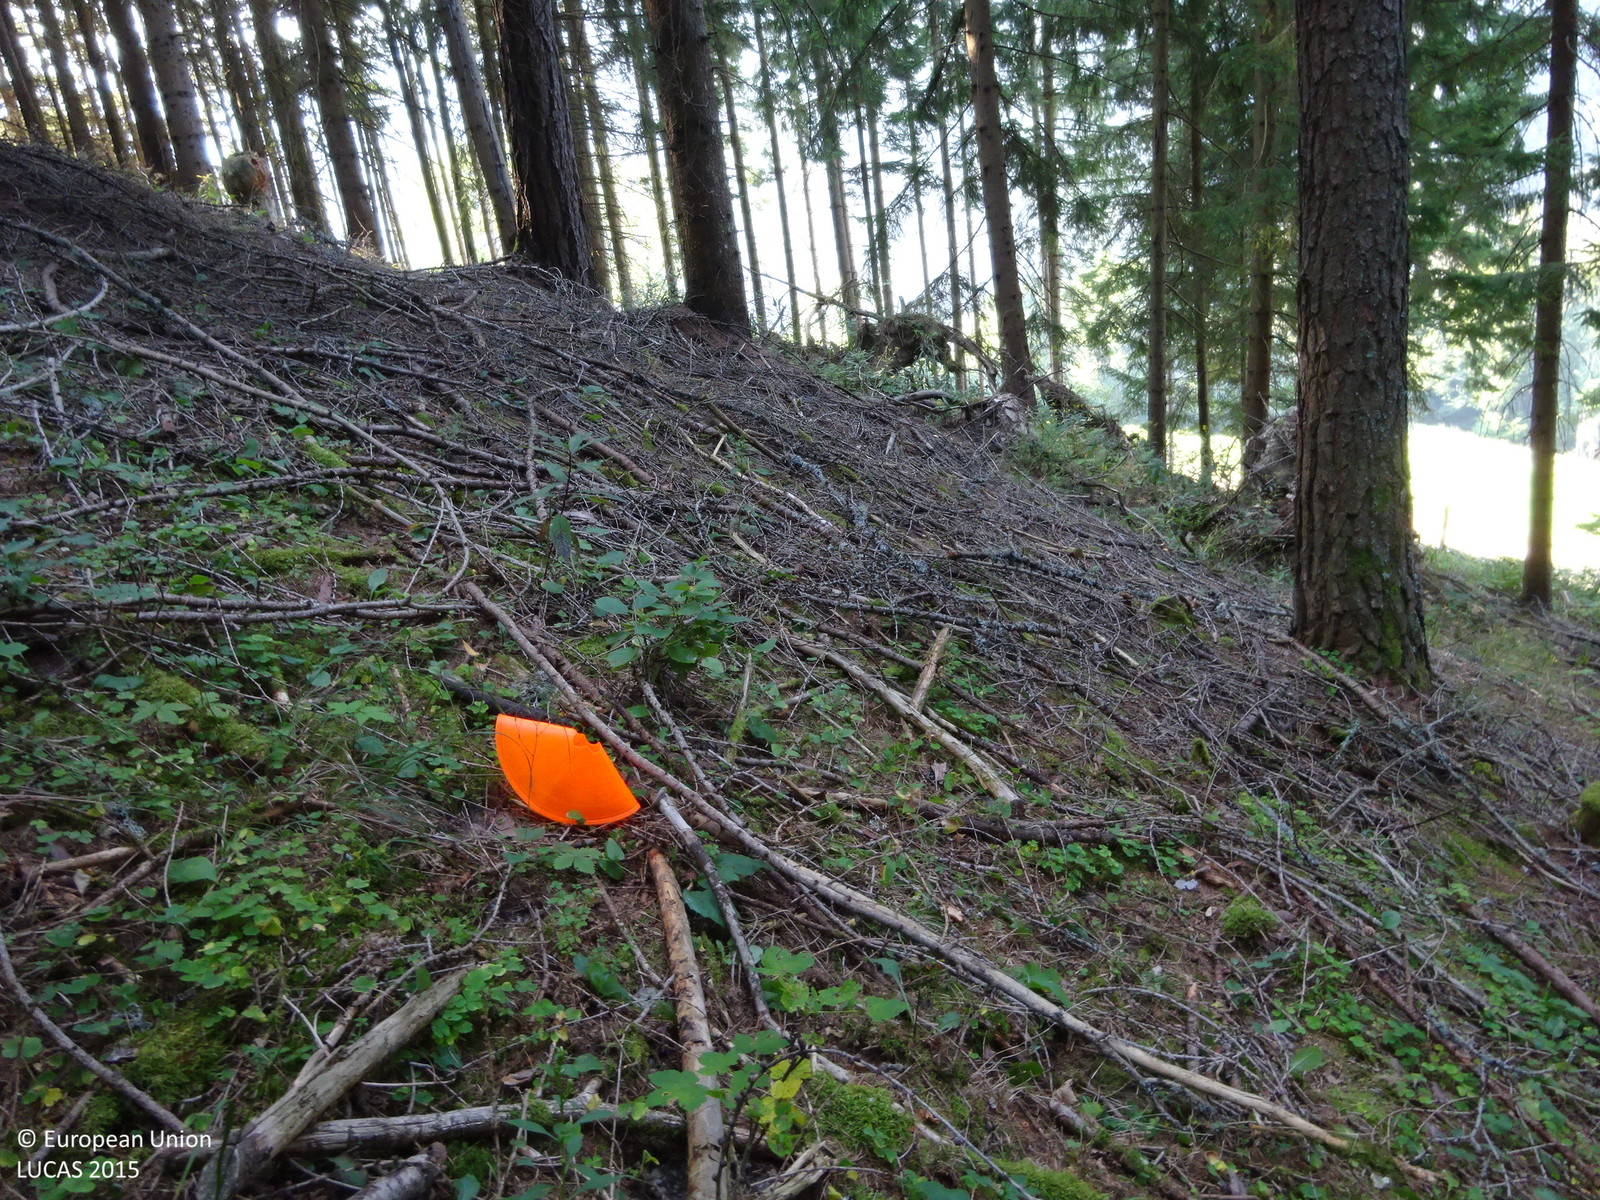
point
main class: Woodland
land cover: Other coniferous woodland
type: alpine coniferous forest
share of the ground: > 75 %
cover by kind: coniferous forest trees 100 %
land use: Forestry
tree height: > 5 m
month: August
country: AT
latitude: 47.4713
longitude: 15.5337
